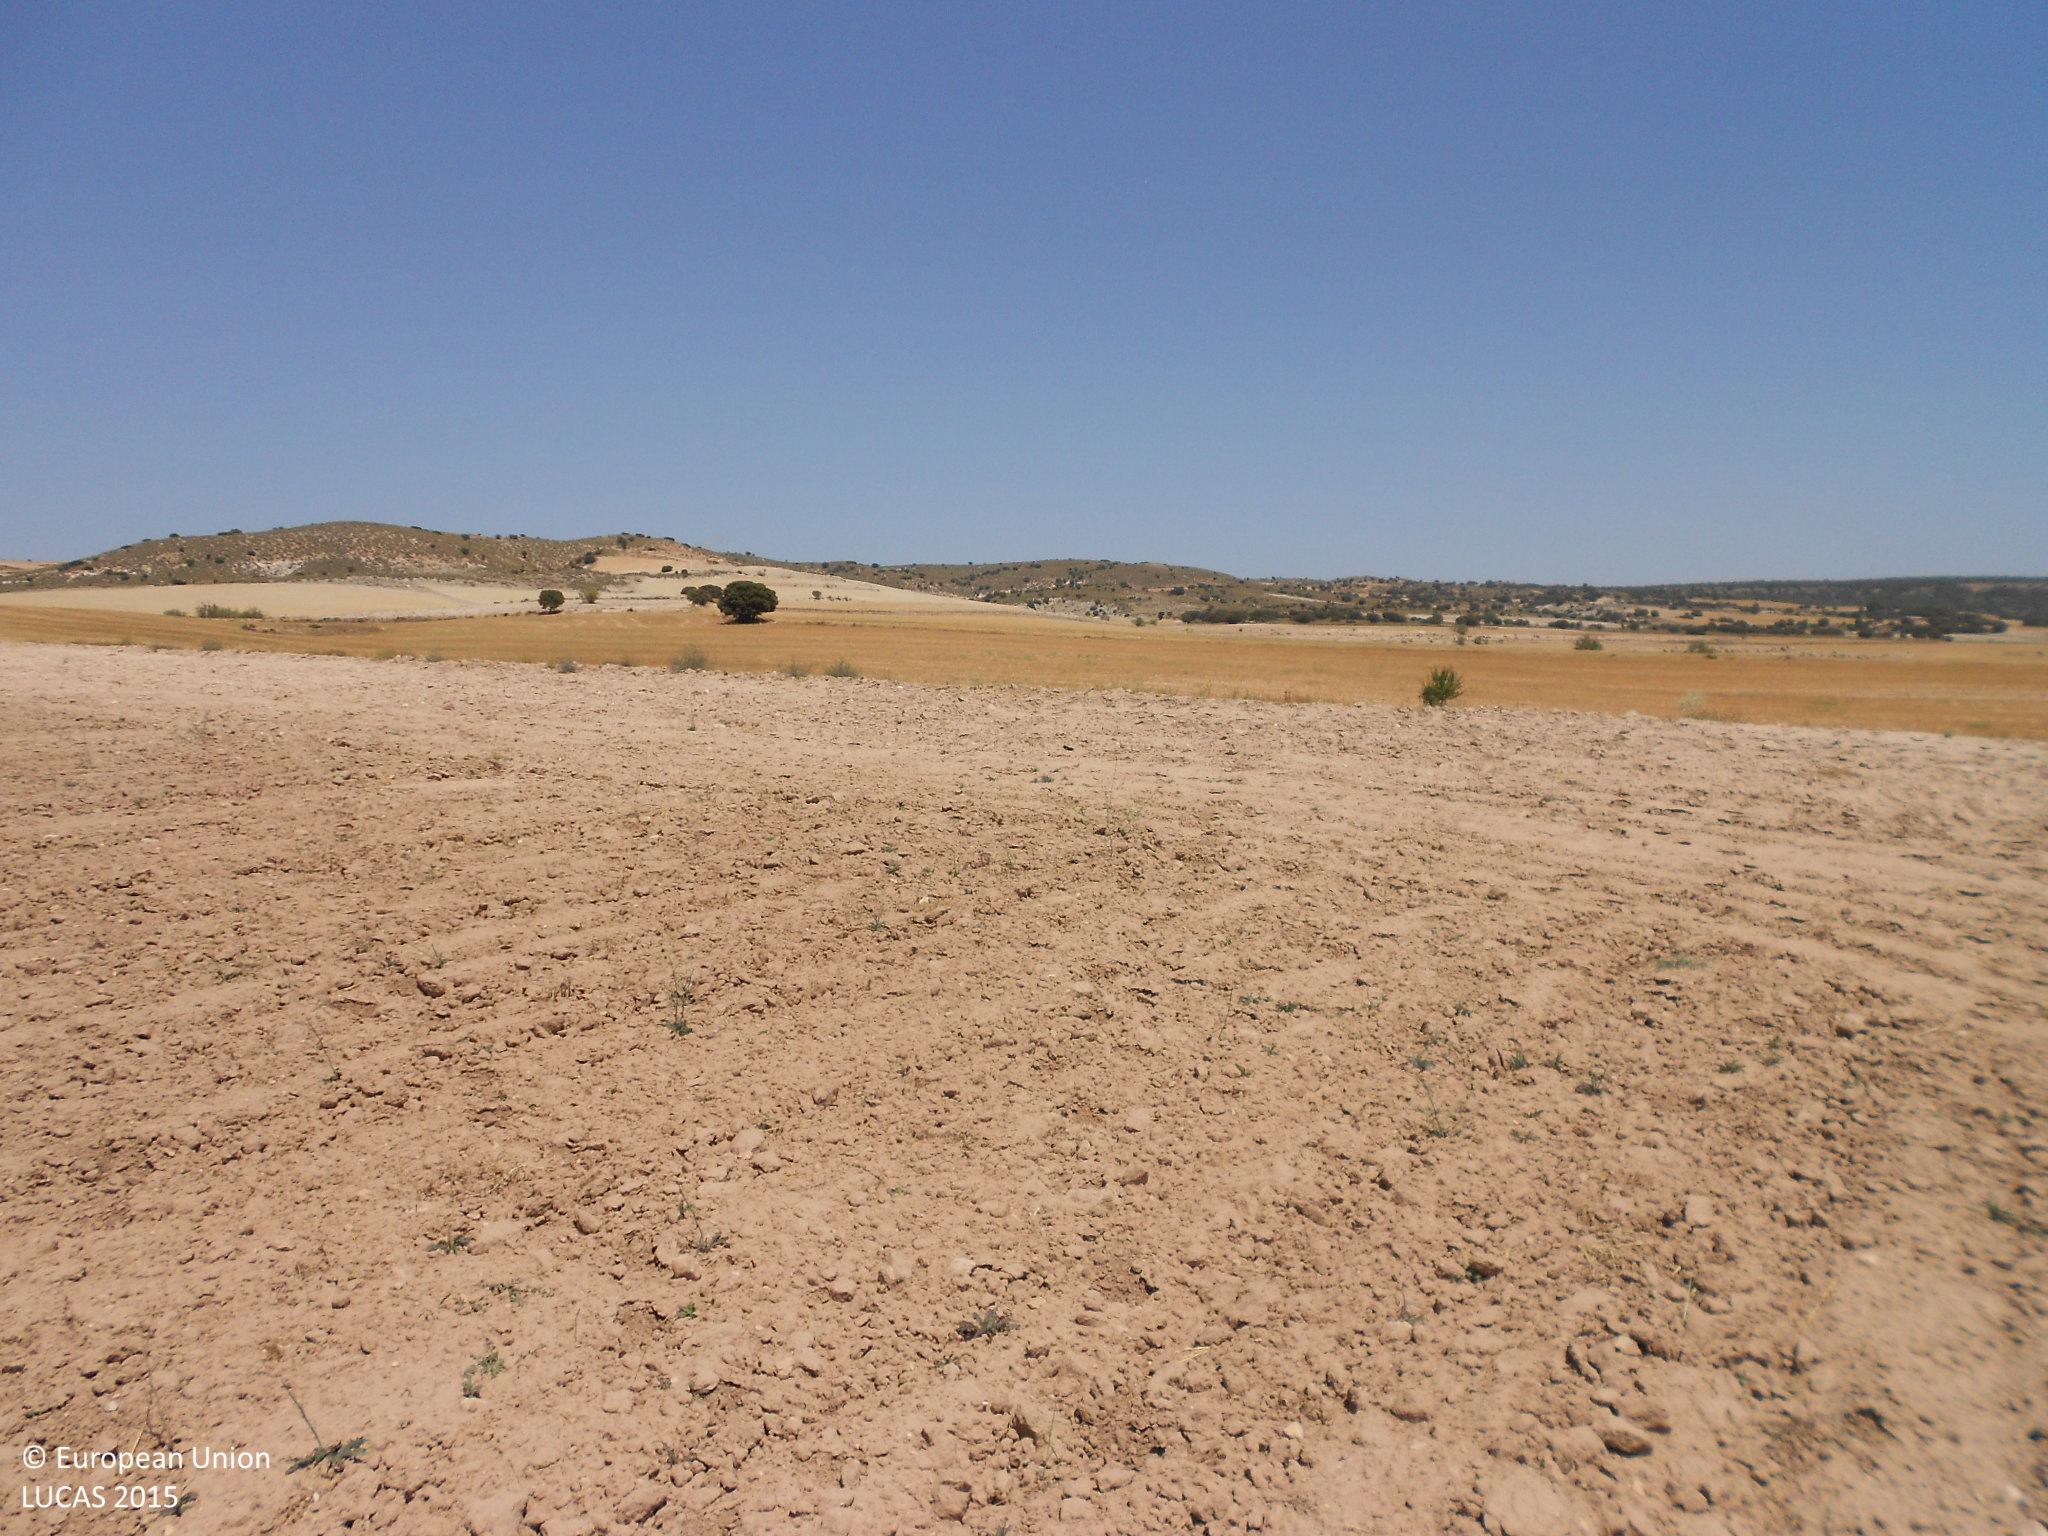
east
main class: Grassland
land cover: Spontaneously vegetated surfaces
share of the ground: 25 - 50 %
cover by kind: consolidated bare surface 60 %, herbaceous plants 40 %
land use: Fallow land
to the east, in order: Spontaneously vegetated surfaces; Grass margins; Common wheat
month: August
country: ES
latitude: 37.7366
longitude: -2.2763
